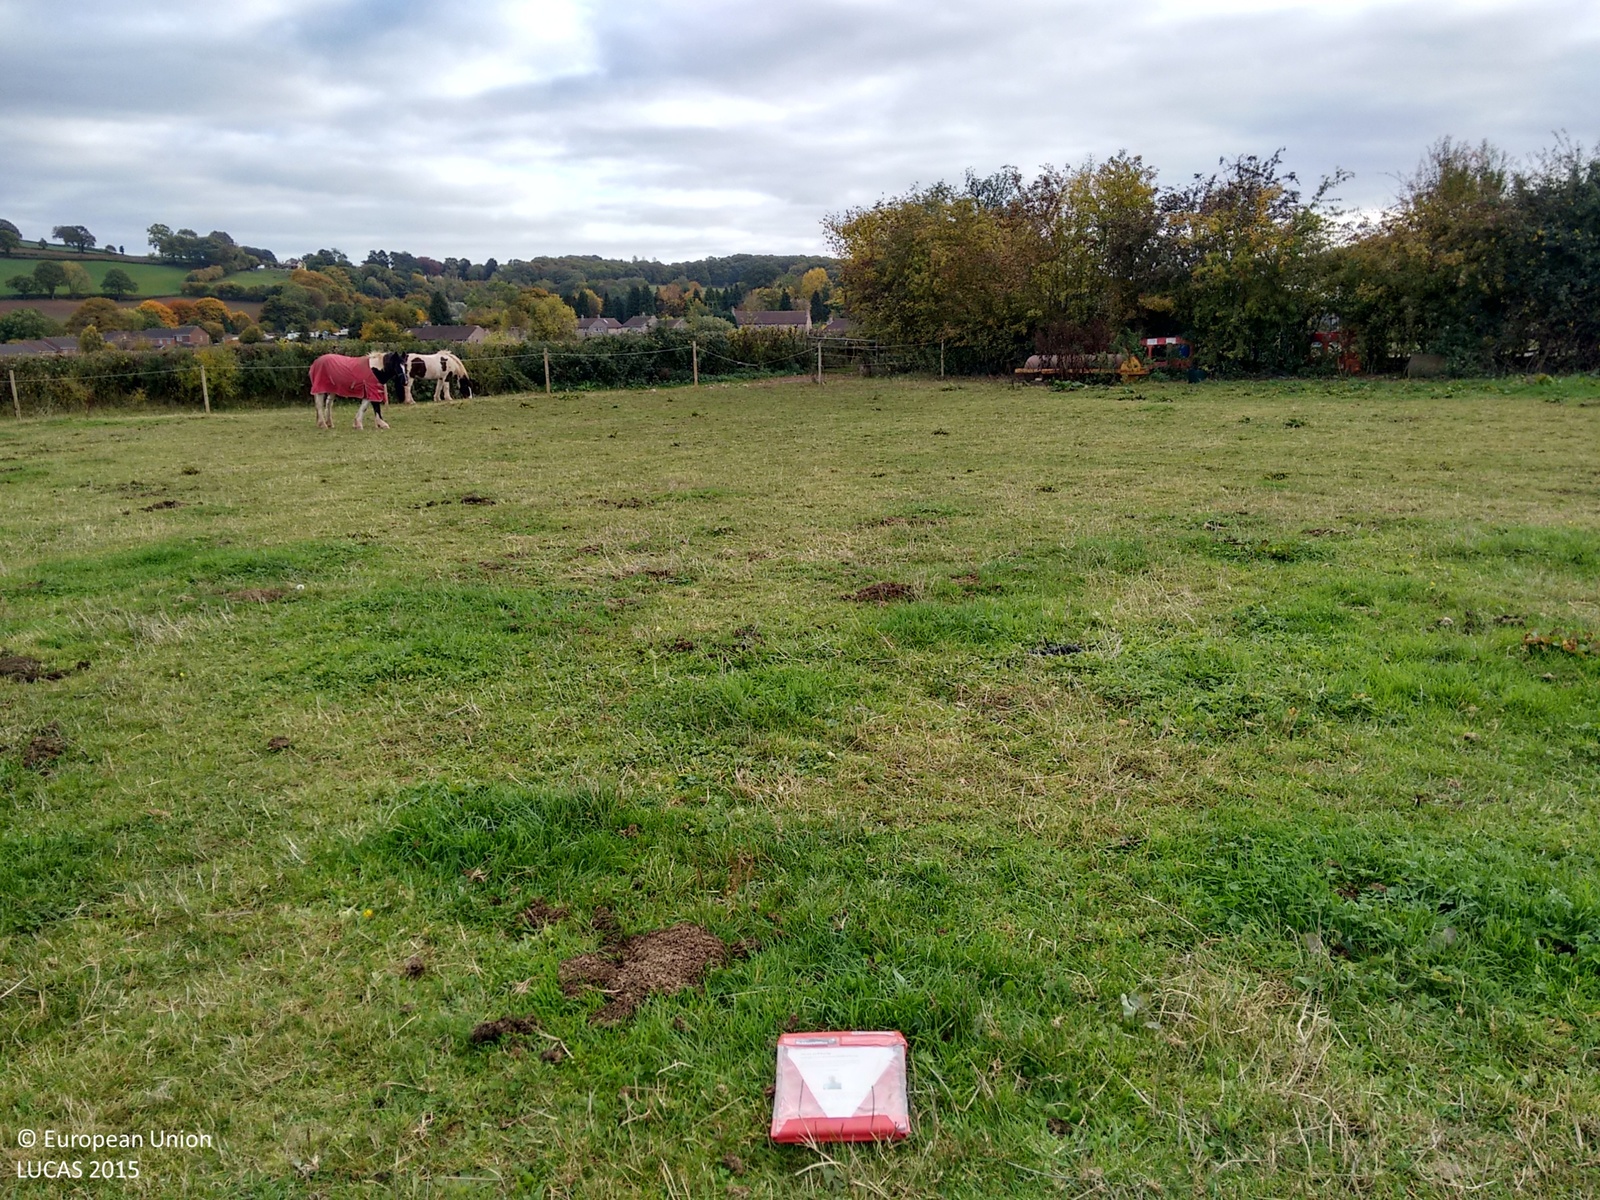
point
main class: Grassland
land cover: Grassland without tree/shrub cover
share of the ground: > 75 %
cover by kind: herbaceous plants 100 %
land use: Agriculture (excluding fallow land and kitchen gardens)
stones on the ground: < 10 %
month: October
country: GB
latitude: 51.8965
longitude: -2.4914
